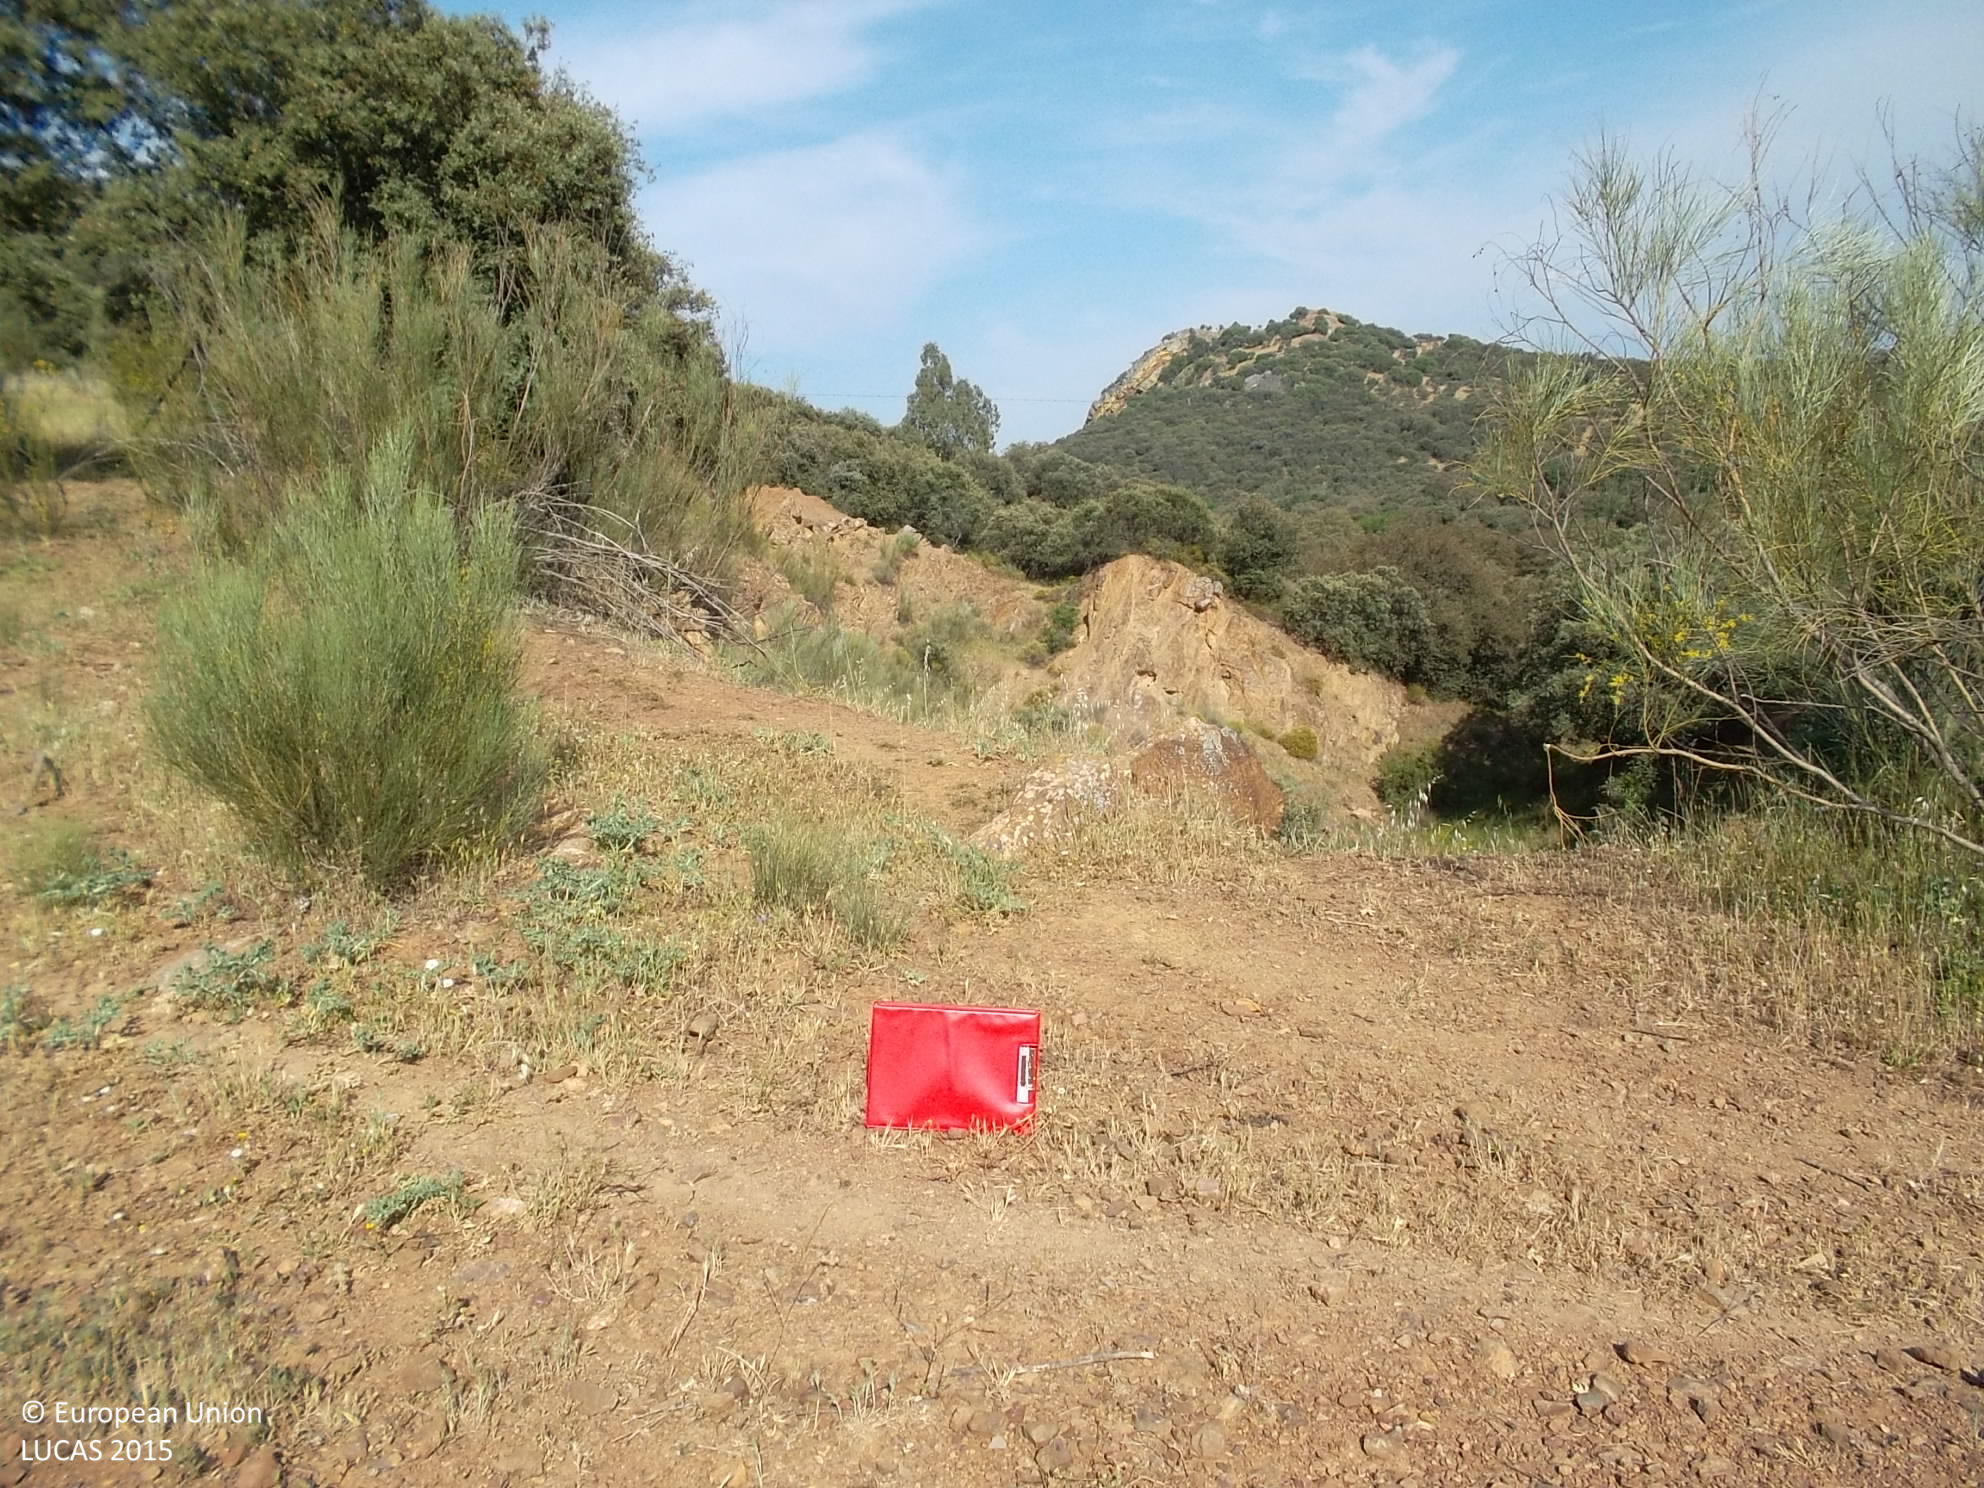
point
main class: Shrubland
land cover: Shrubland with sparse tree cover
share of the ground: 10 - 25 %
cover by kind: herbaceous plants 85 %, shrubs 10 %, broadleaved forest trees 5 %
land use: Agriculture (excluding fallow land and kitchen gardens)
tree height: > 5 m
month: May
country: ES
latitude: 38.7605
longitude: -4.7468
